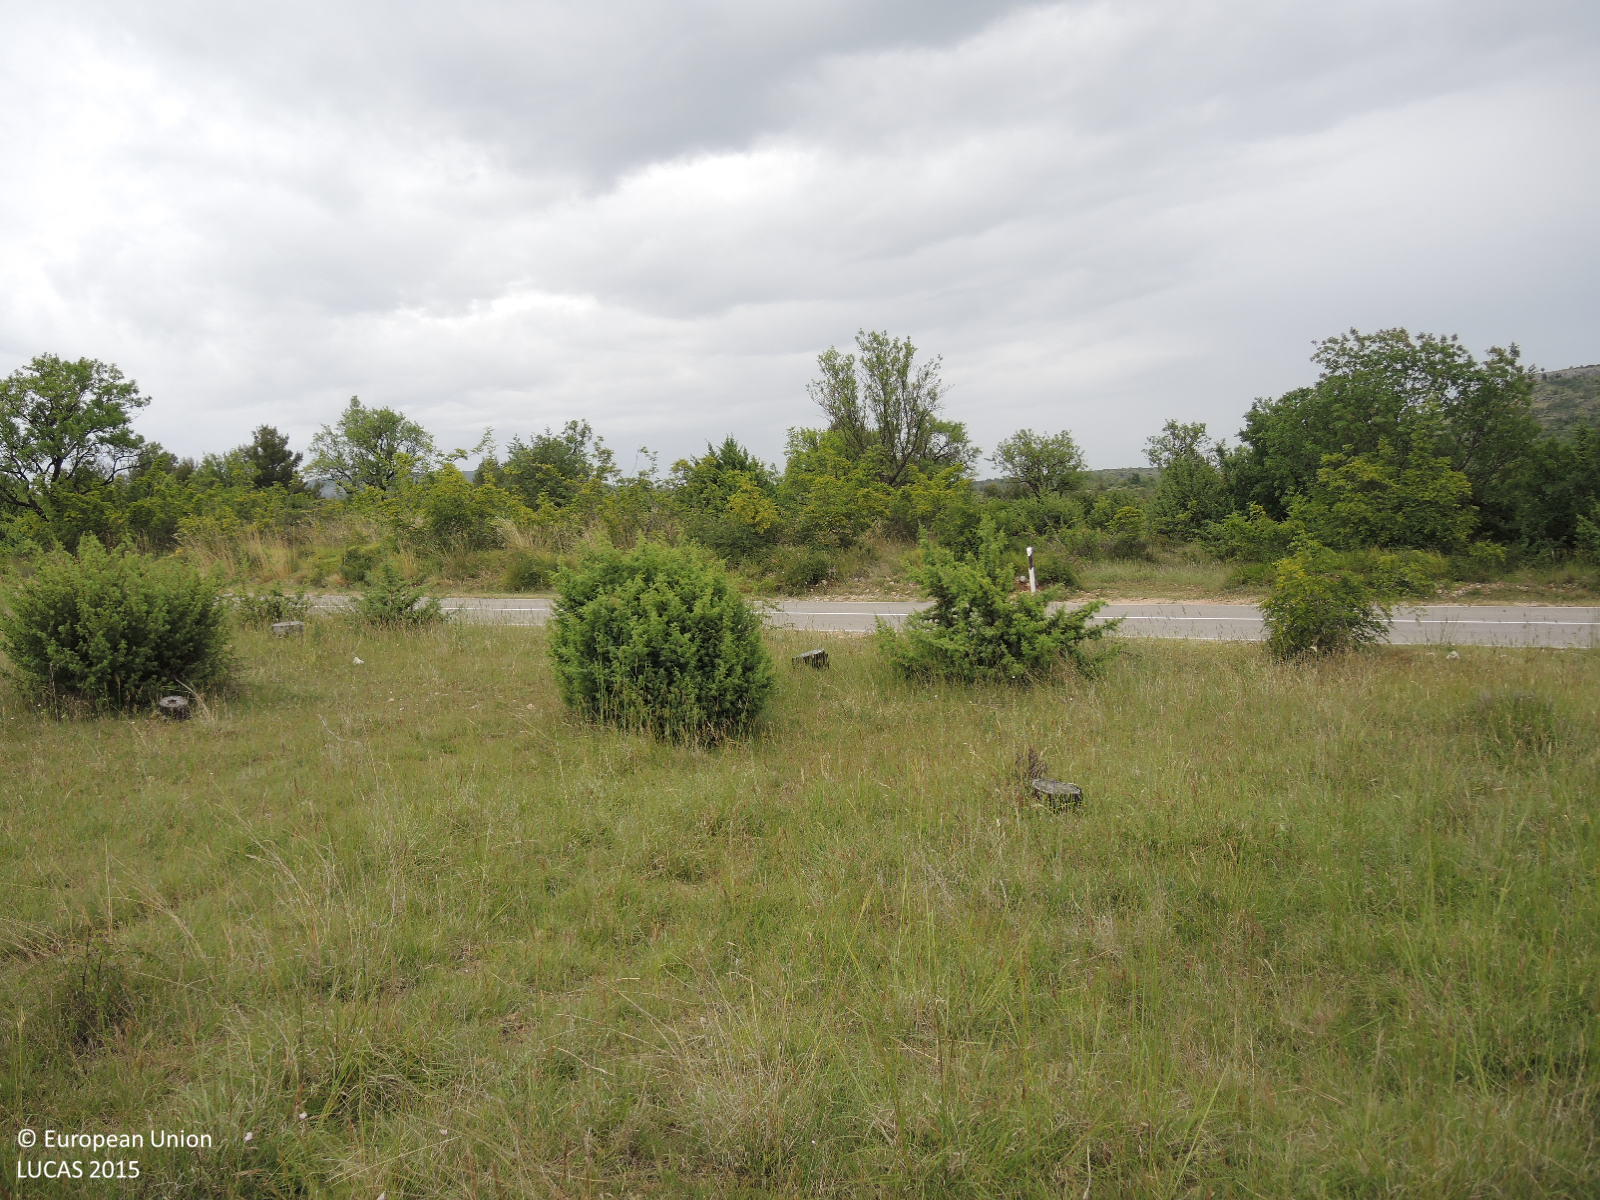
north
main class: Shrubland
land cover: Shrubland without tree cover
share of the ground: 10 - 25 %
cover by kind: herbaceous plants 65 %, shrubs 25 %, unconsolidated bare surface 10 %
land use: Semi-natural and natural areas not in use
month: May
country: HR
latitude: 43.9153
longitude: 15.8322
